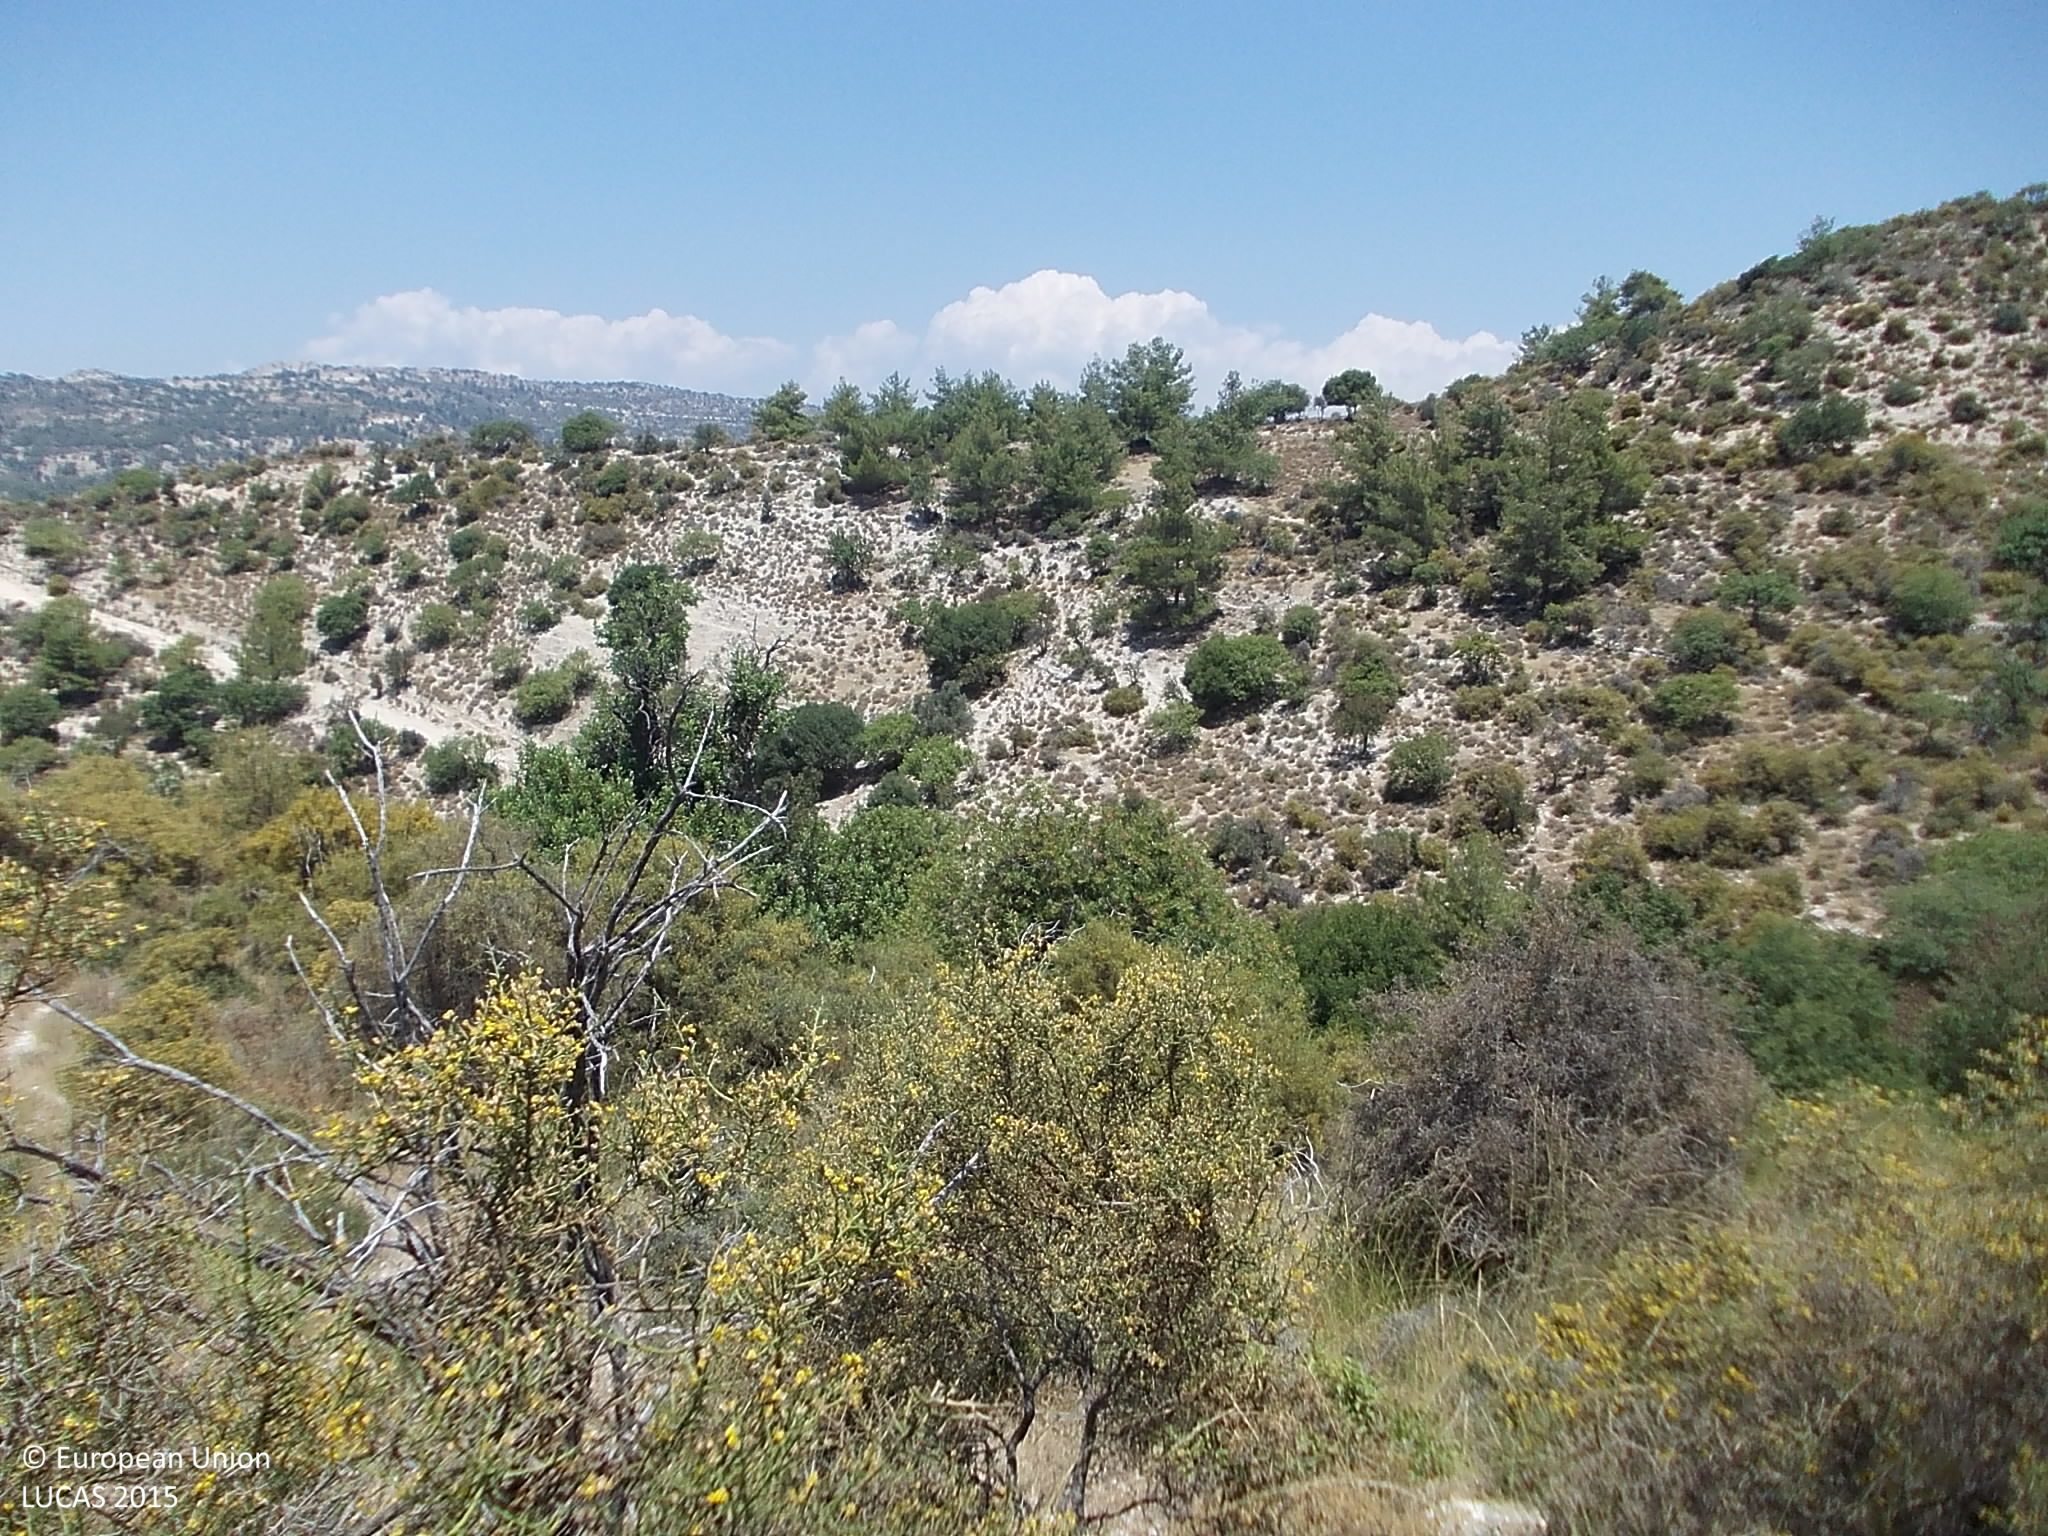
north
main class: Shrubland
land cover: Shrubland with sparse tree cover
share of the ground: 50 - 75 %
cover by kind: shrubs 65 %, herbaceous plants 15 %, unconsolidated bare surface 15 %, broadleaved forest trees 5 %
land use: Semi-natural and natural areas not in use
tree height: > 5 m
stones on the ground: 25 - 50 %
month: July
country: CY
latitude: 34.7370
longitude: 32.7077
